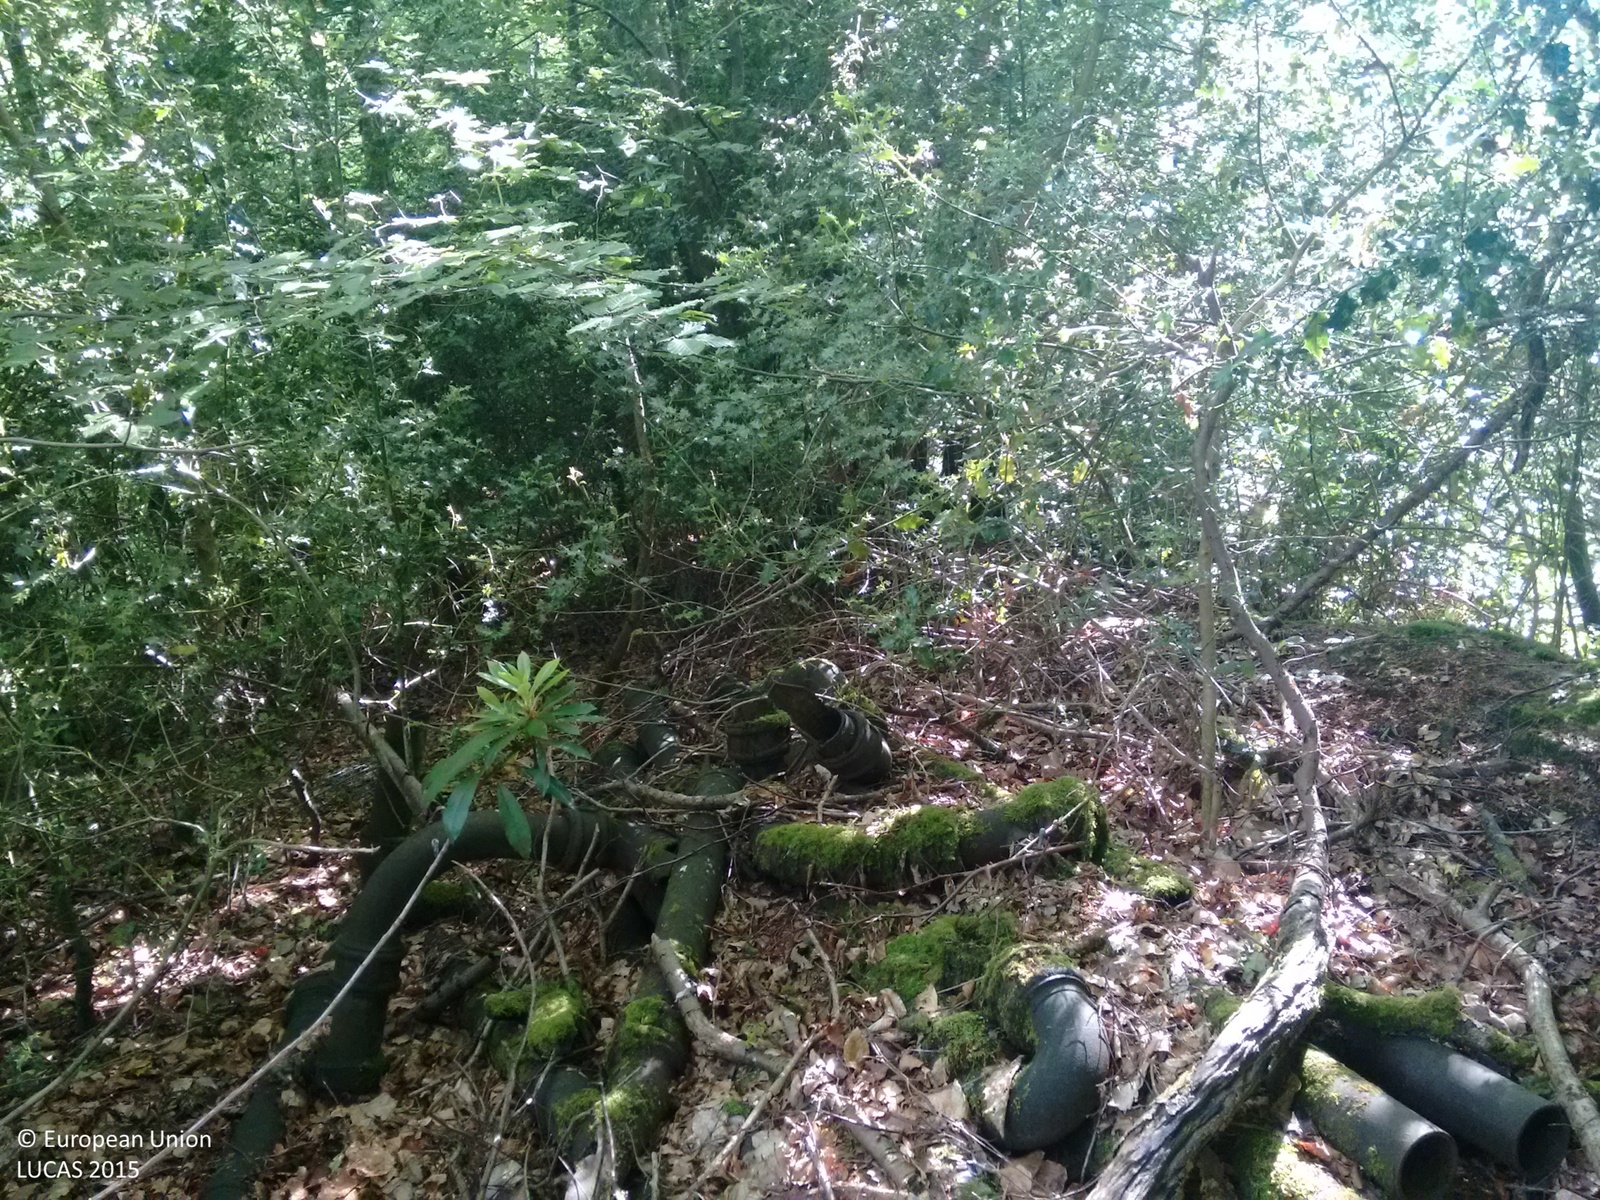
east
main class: Woodland
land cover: Other mixed woodland
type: mesophytic deciduous forest
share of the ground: > 75 %
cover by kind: broadleaved forest trees 75 %, coniferous forest trees 25 %
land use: Semi-natural and natural areas not in use
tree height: > 5 m
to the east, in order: Other mixed woodland; Fences; Other mixed woodland; Paved roads, cycling and walking lanes; Grass margins; Electric lines; Broadleaved woodland; Grassland without tree/shrub cover; Fences; Grassland without tree/shrub cover
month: June
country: GB
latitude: 50.9759
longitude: 0.2134
